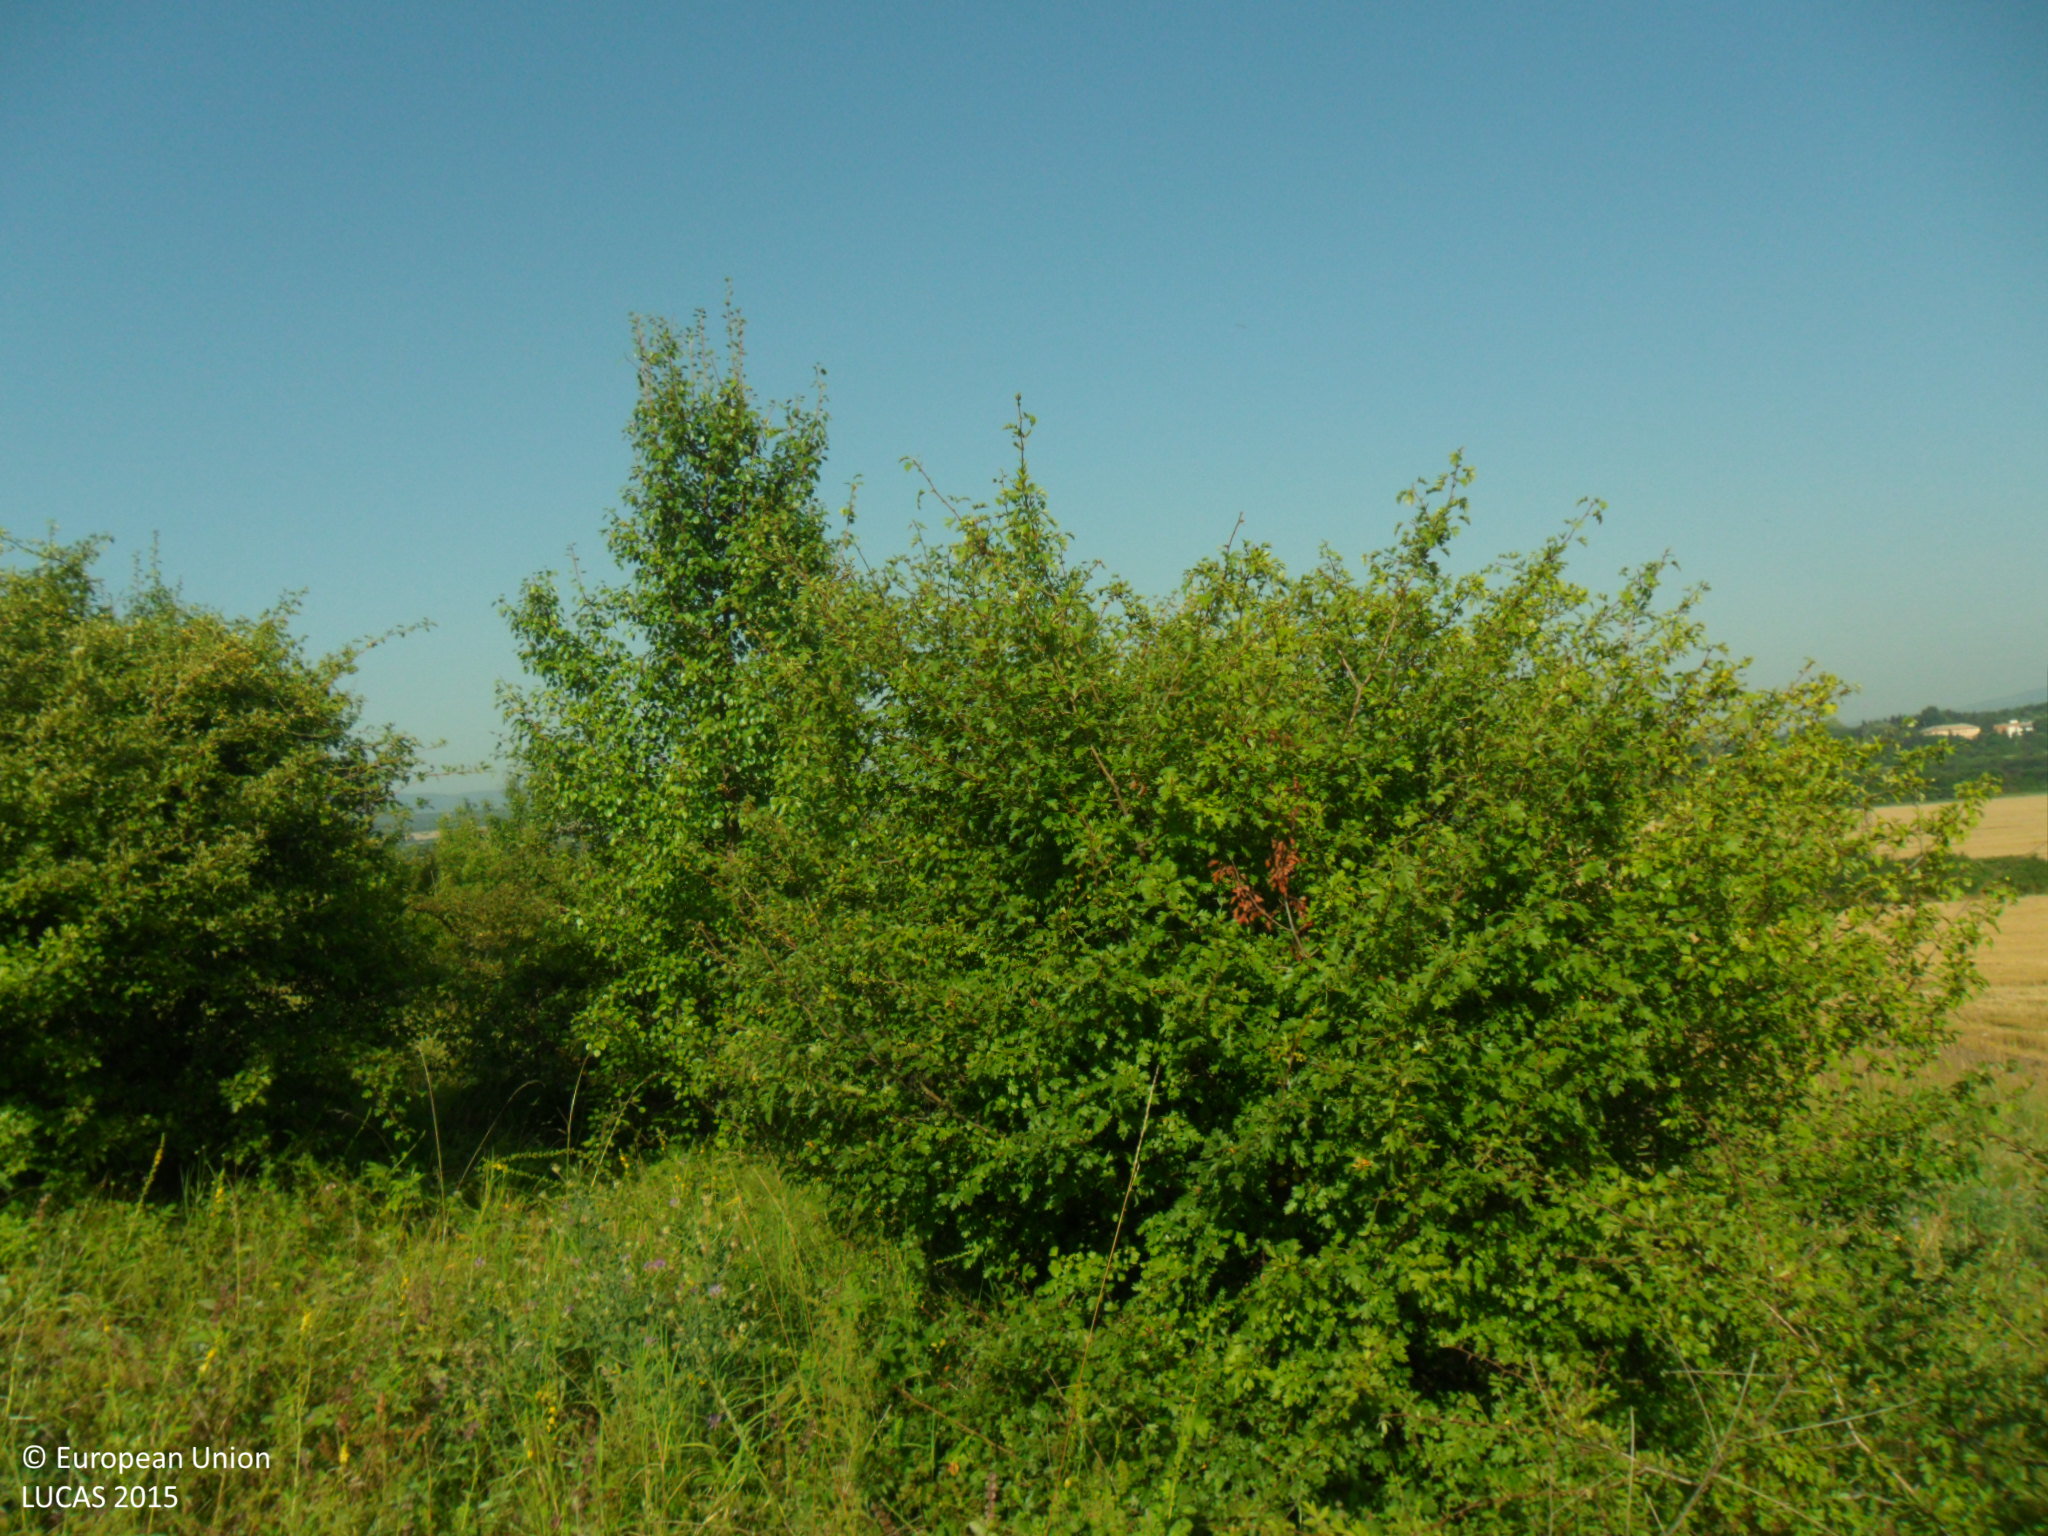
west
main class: Shrubland
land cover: Shrubland with sparse tree cover
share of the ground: > 75 %
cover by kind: shrubs 75 %, herbaceous plants 20 %, broadleaved forest trees 5 %
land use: Forestry
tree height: < 5 m
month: July
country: BG
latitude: 43.1698
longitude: 27.0275
